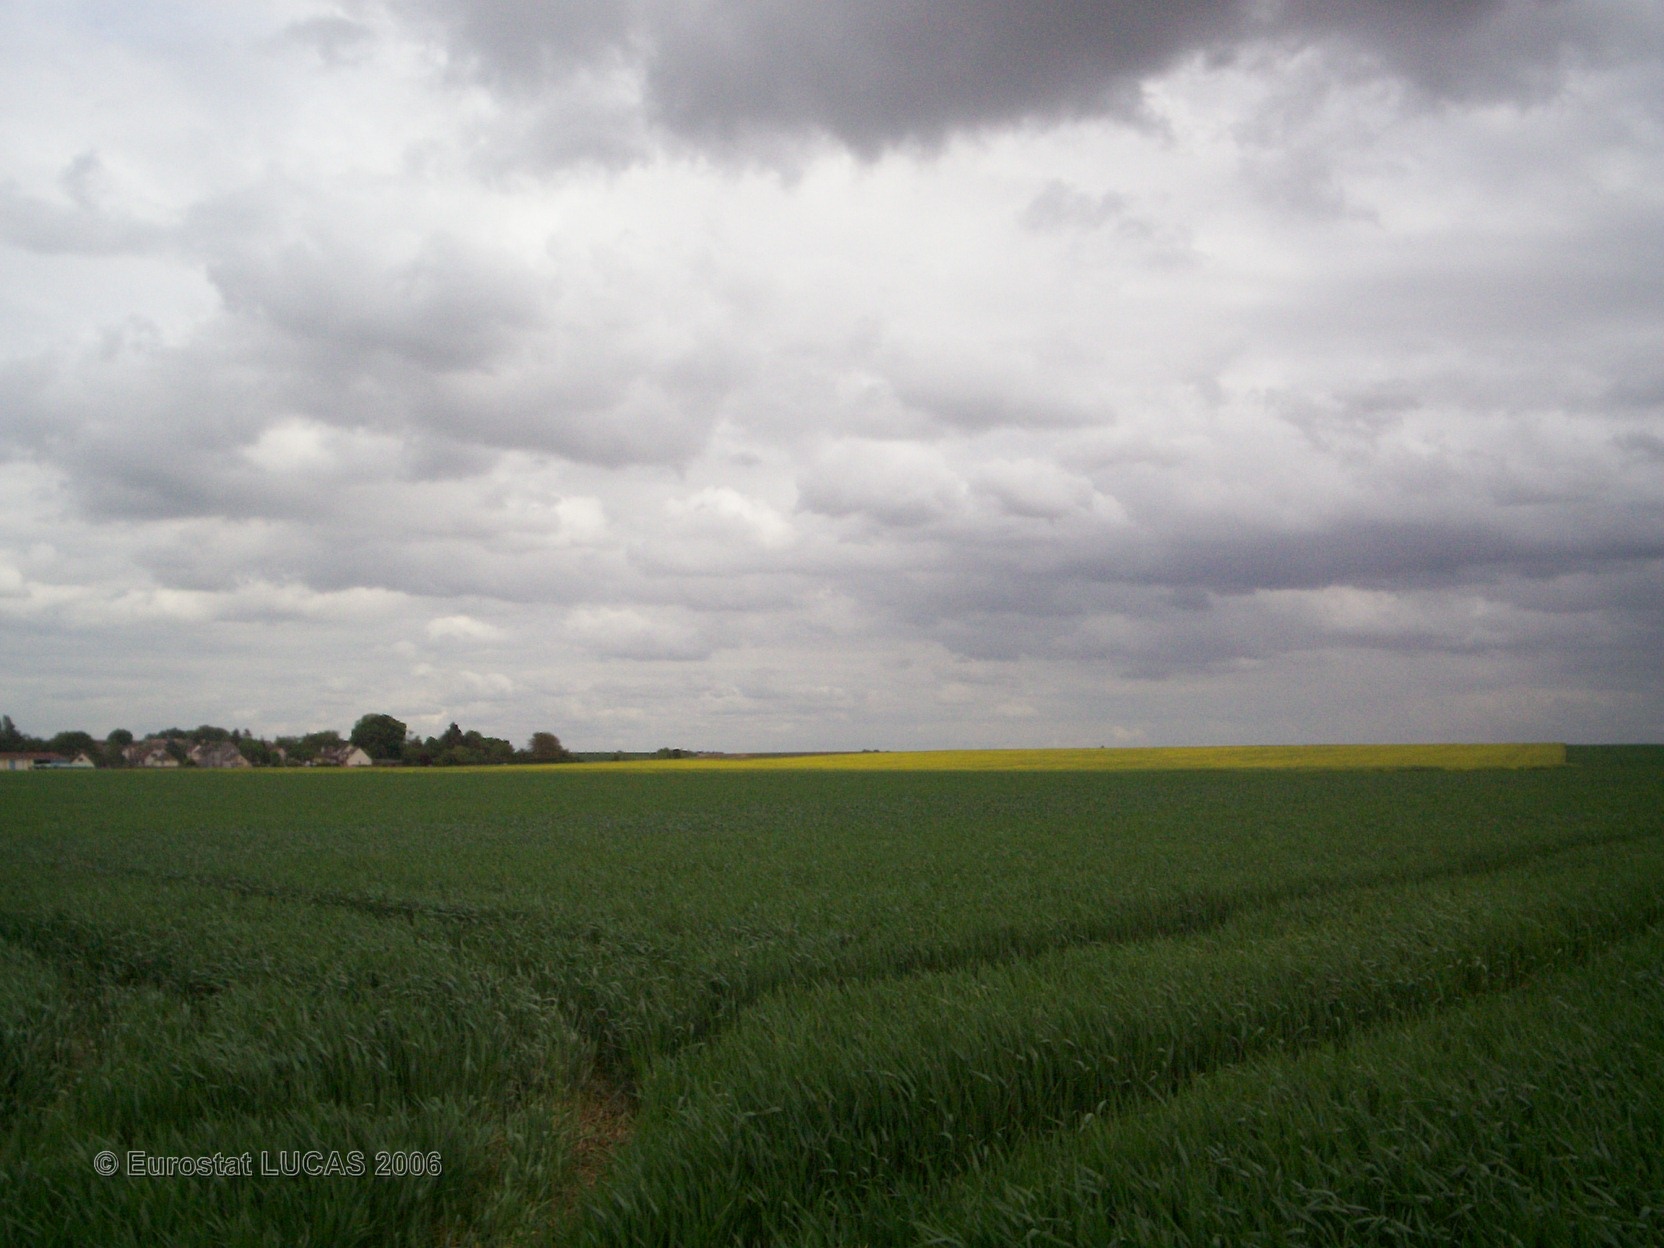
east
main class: Cropland
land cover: Common wheat
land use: Agriculture (excluding fallow land and kitchen gardens)
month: May
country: FR
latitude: 49.1060
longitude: 2.7710
